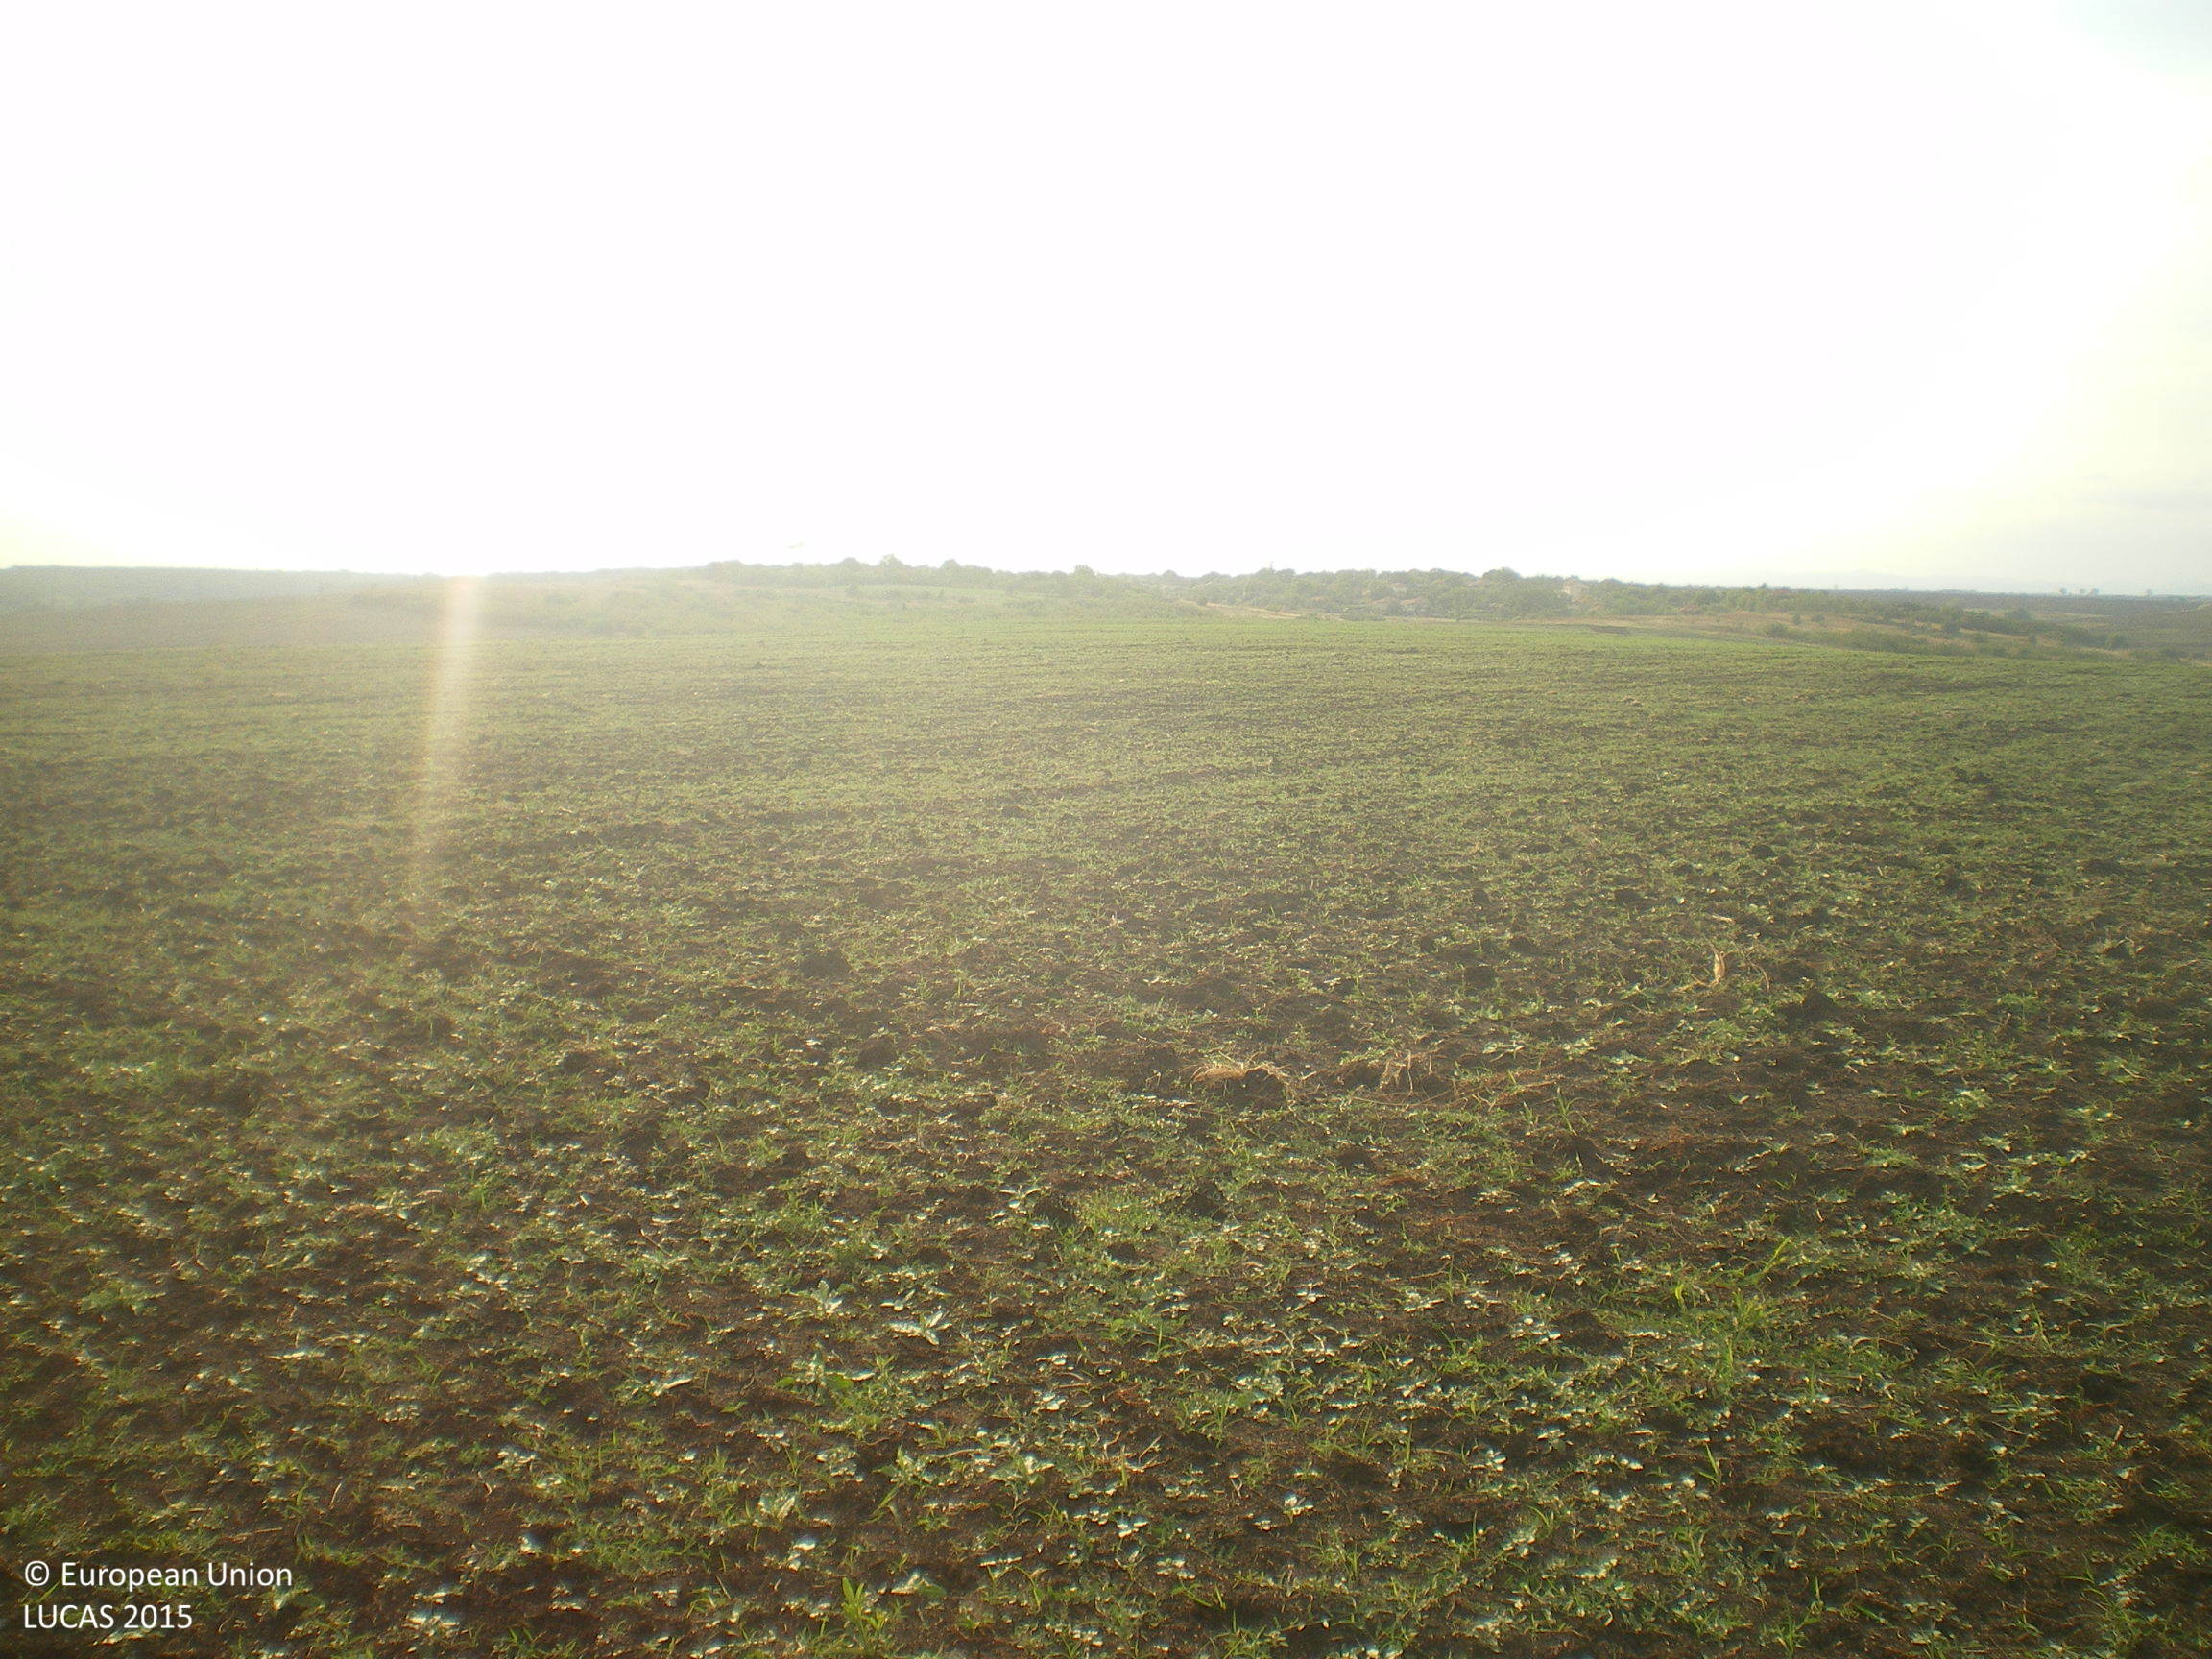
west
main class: Grassland
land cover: Spontaneously vegetated surfaces
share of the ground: 10 - 25 %
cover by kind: herbaceous plants 60 %, consolidated bare surface 40 %
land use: Agriculture (excluding fallow land and kitchen gardens)
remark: Harvested field
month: September
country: BG
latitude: 42.2117
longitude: 25.8078
